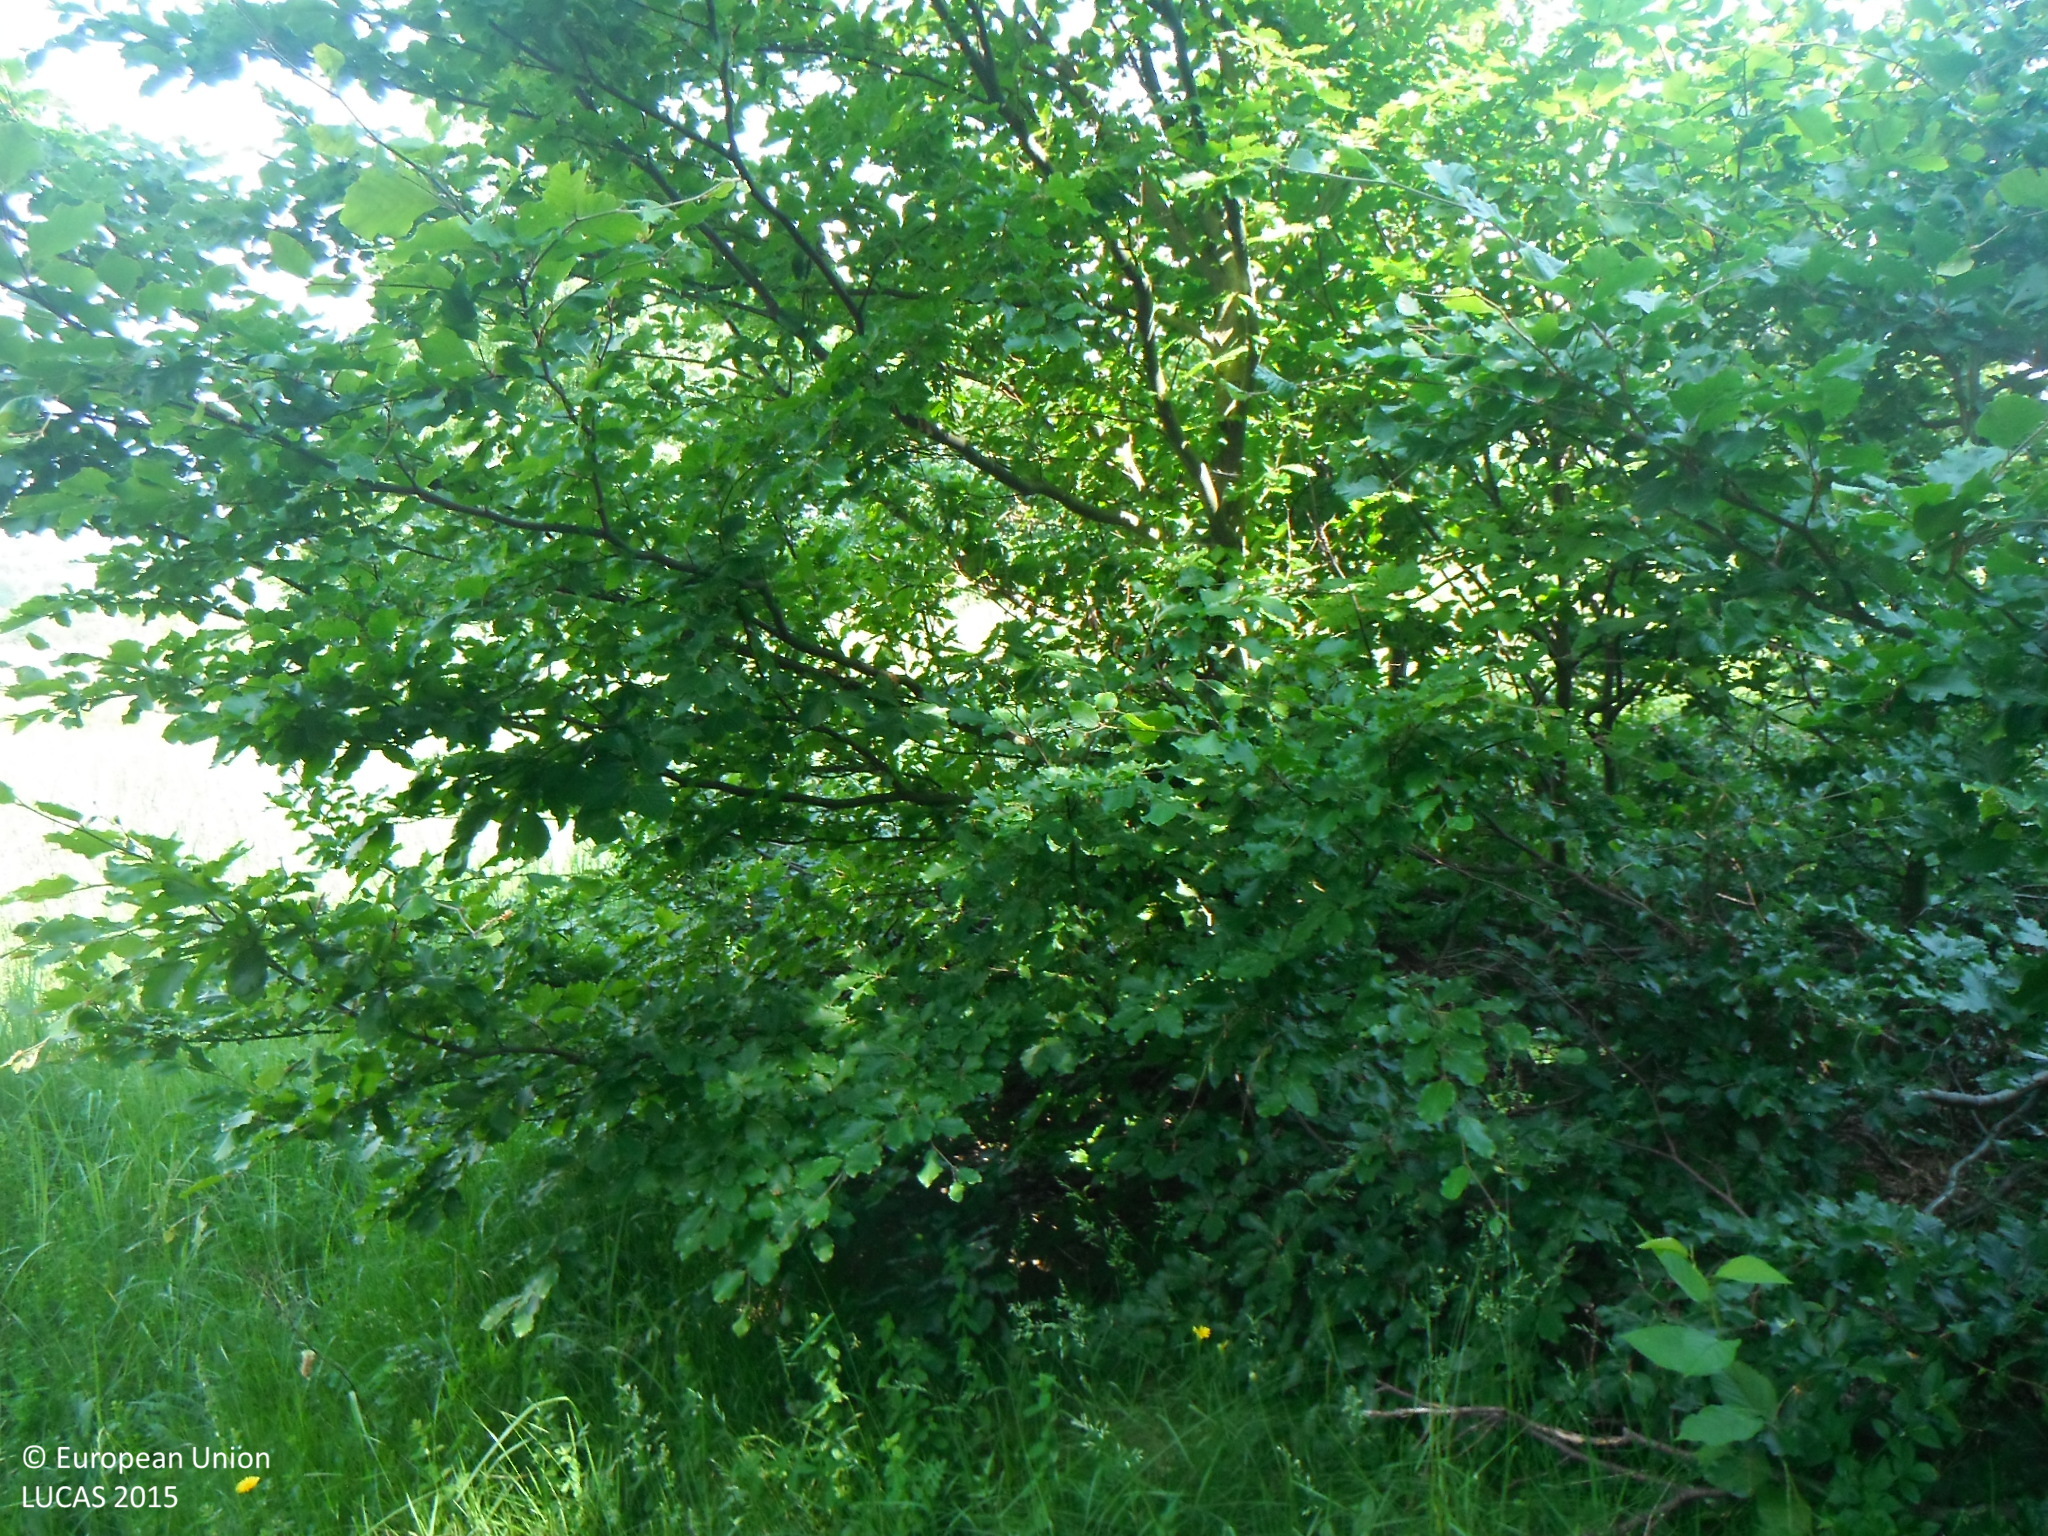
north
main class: Woodland
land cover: Broadleaved woodland
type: beech forest
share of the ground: 50 - 75 %
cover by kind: broadleaved forest trees 55 %, herbaceous plants 40 %, shrubs 5 %
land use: Forestry
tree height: > 5 m
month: June
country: SK
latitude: 48.4866
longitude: 19.4549
